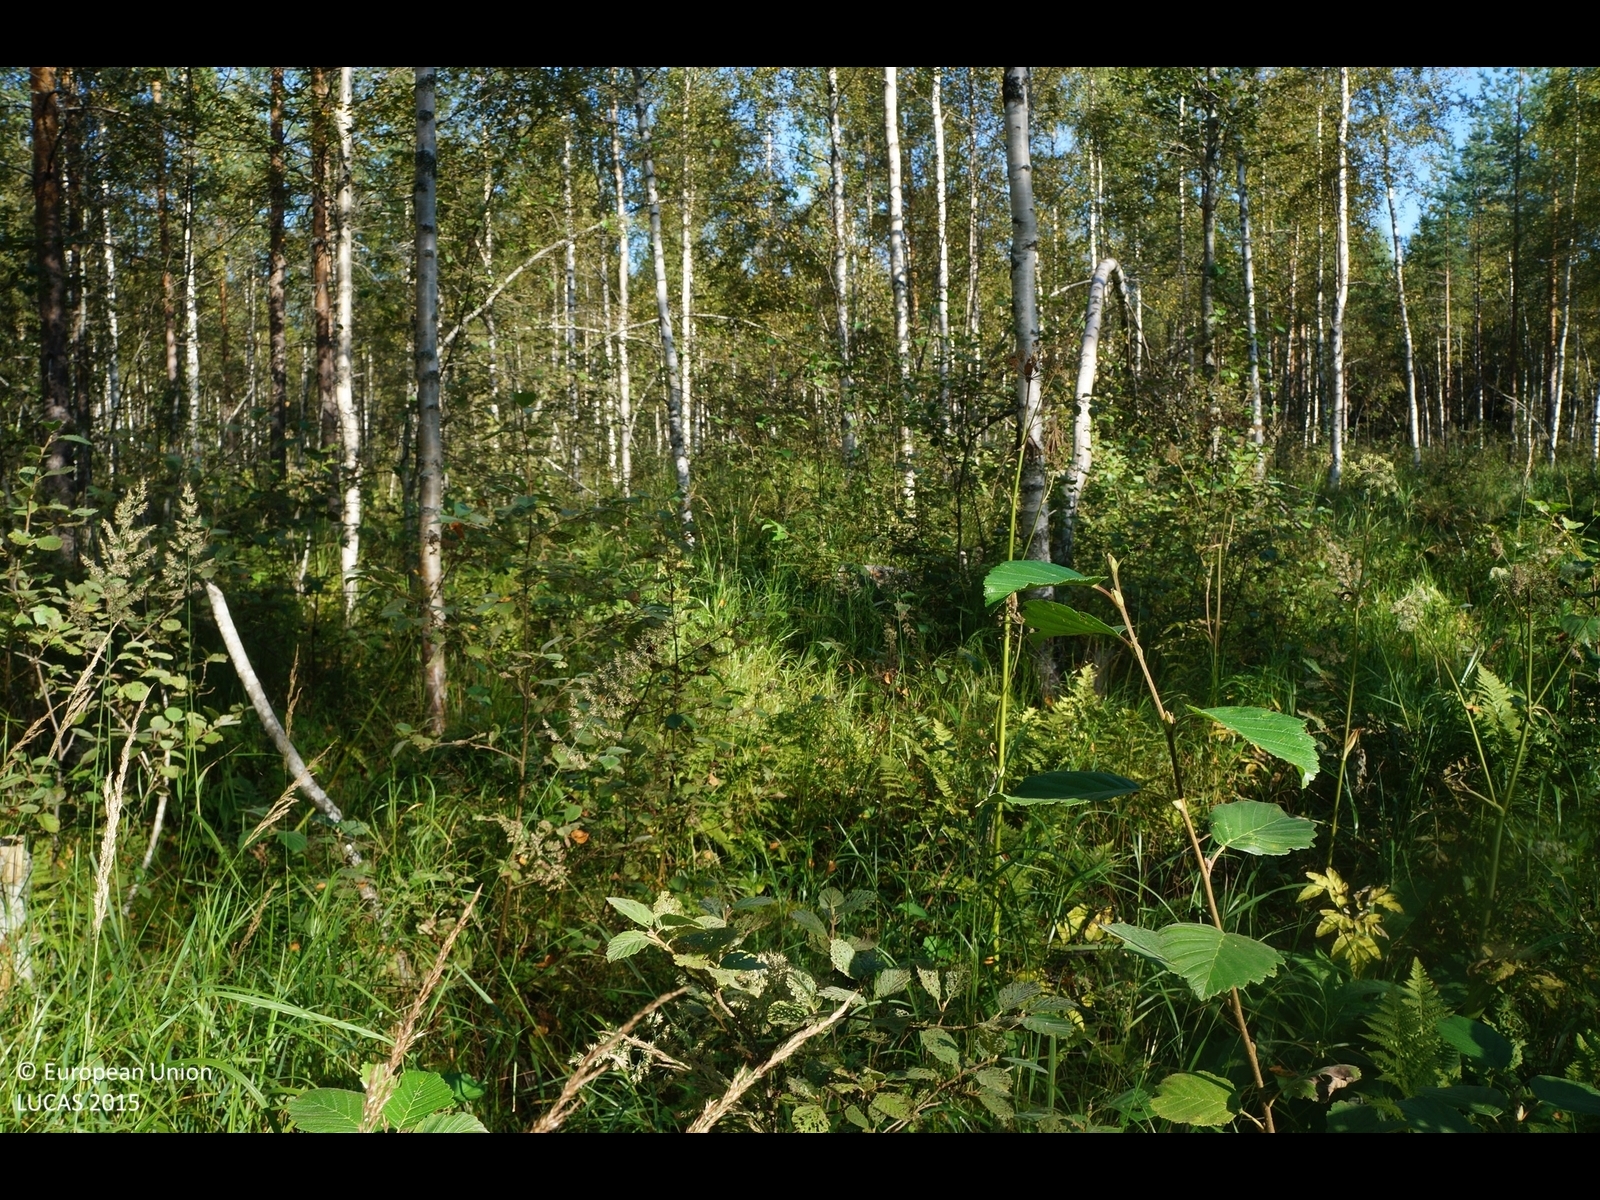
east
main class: Woodland
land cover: Broadleaved woodland
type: non-riverine alder, birch or aspen forest
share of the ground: 25 - 50 %
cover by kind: broadleaved forest trees 40 %, herbaceous plants 40 %, shrubs 20 %
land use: Forestry
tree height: > 5 m
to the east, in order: Broadleaved woodland; Grassland without tree/shrub cover; Broadleaved woodland; Pine dominated mixed woodland; Pine dominated coniferous woodland
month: August
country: FI
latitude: 64.0861
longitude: 24.9937
